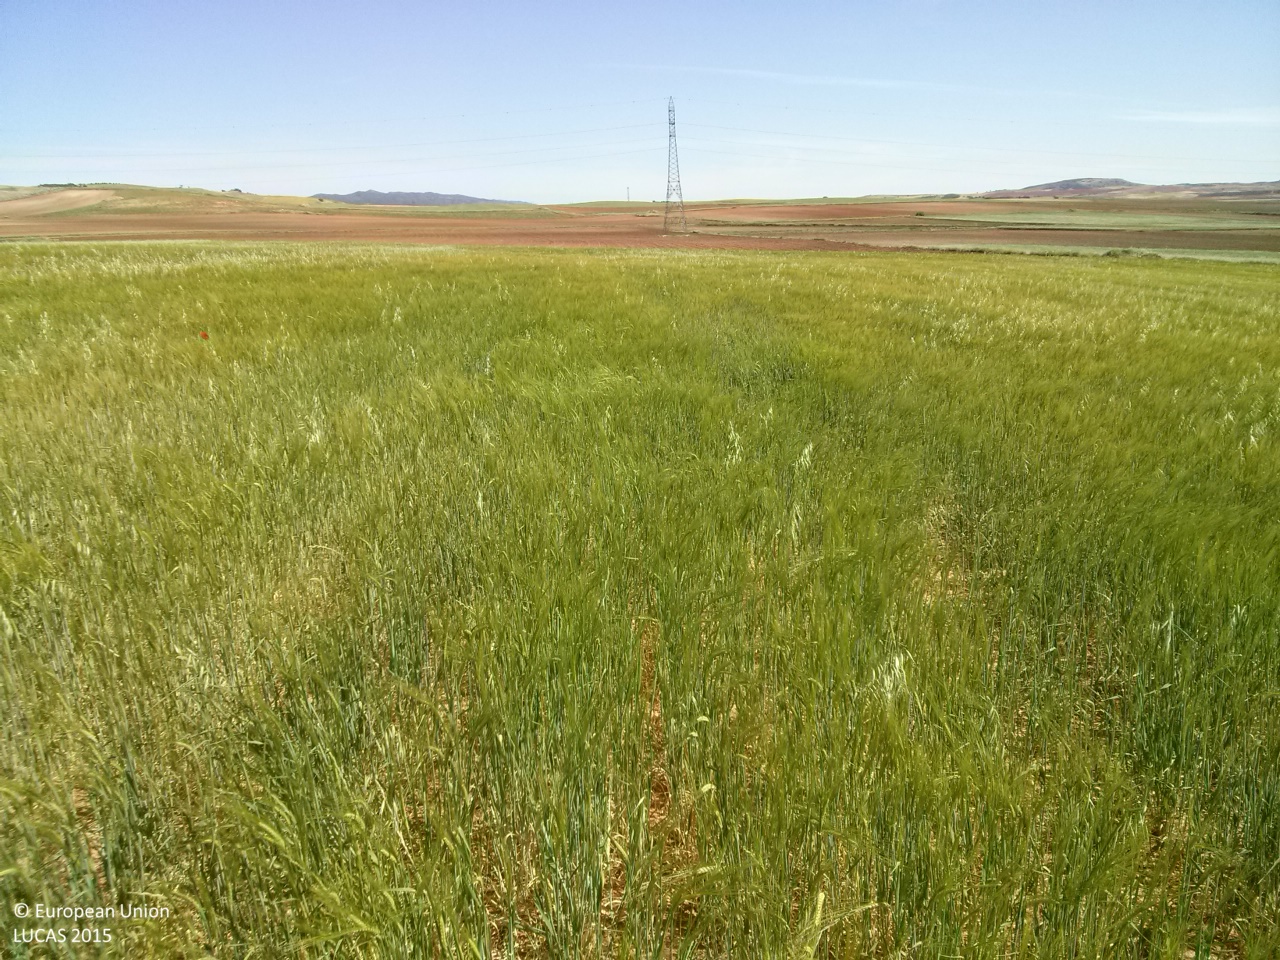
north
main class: Cropland
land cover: Barley
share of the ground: > 75 %
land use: Agriculture (excluding fallow land and kitchen gardens)
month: May
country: ES
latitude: 40.0072
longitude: -2.8257
